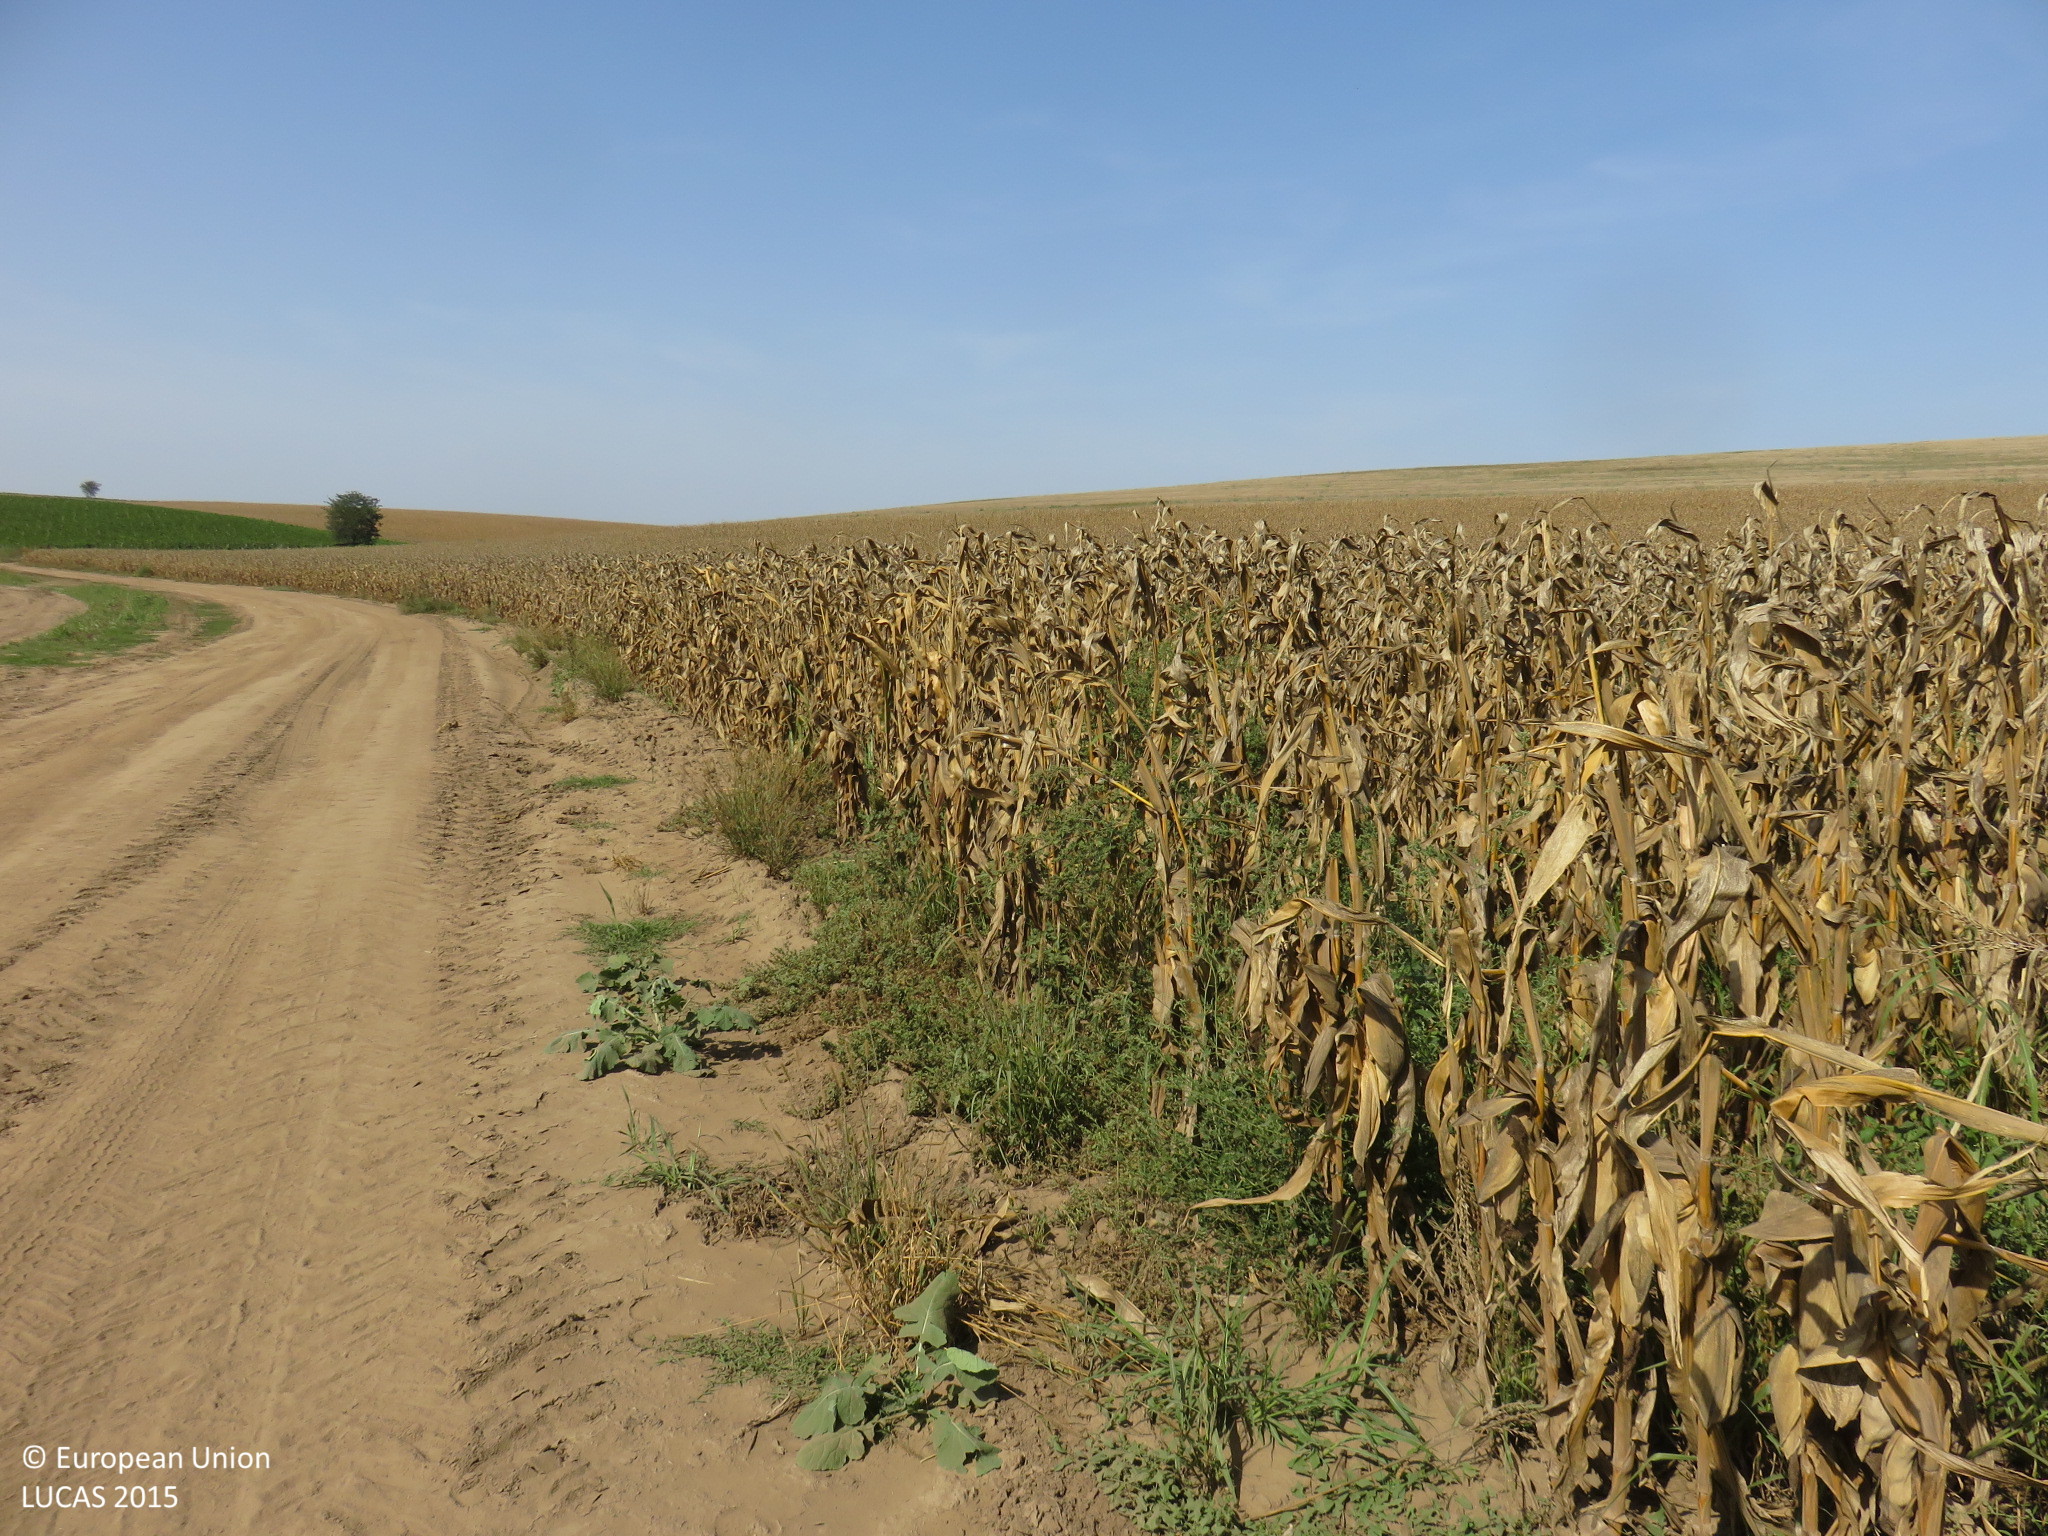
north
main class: Cropland
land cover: Maize
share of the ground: > 75 %
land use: Agriculture (excluding fallow land and kitchen gardens)
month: September
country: BG
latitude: 43.5518
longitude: 24.5832
